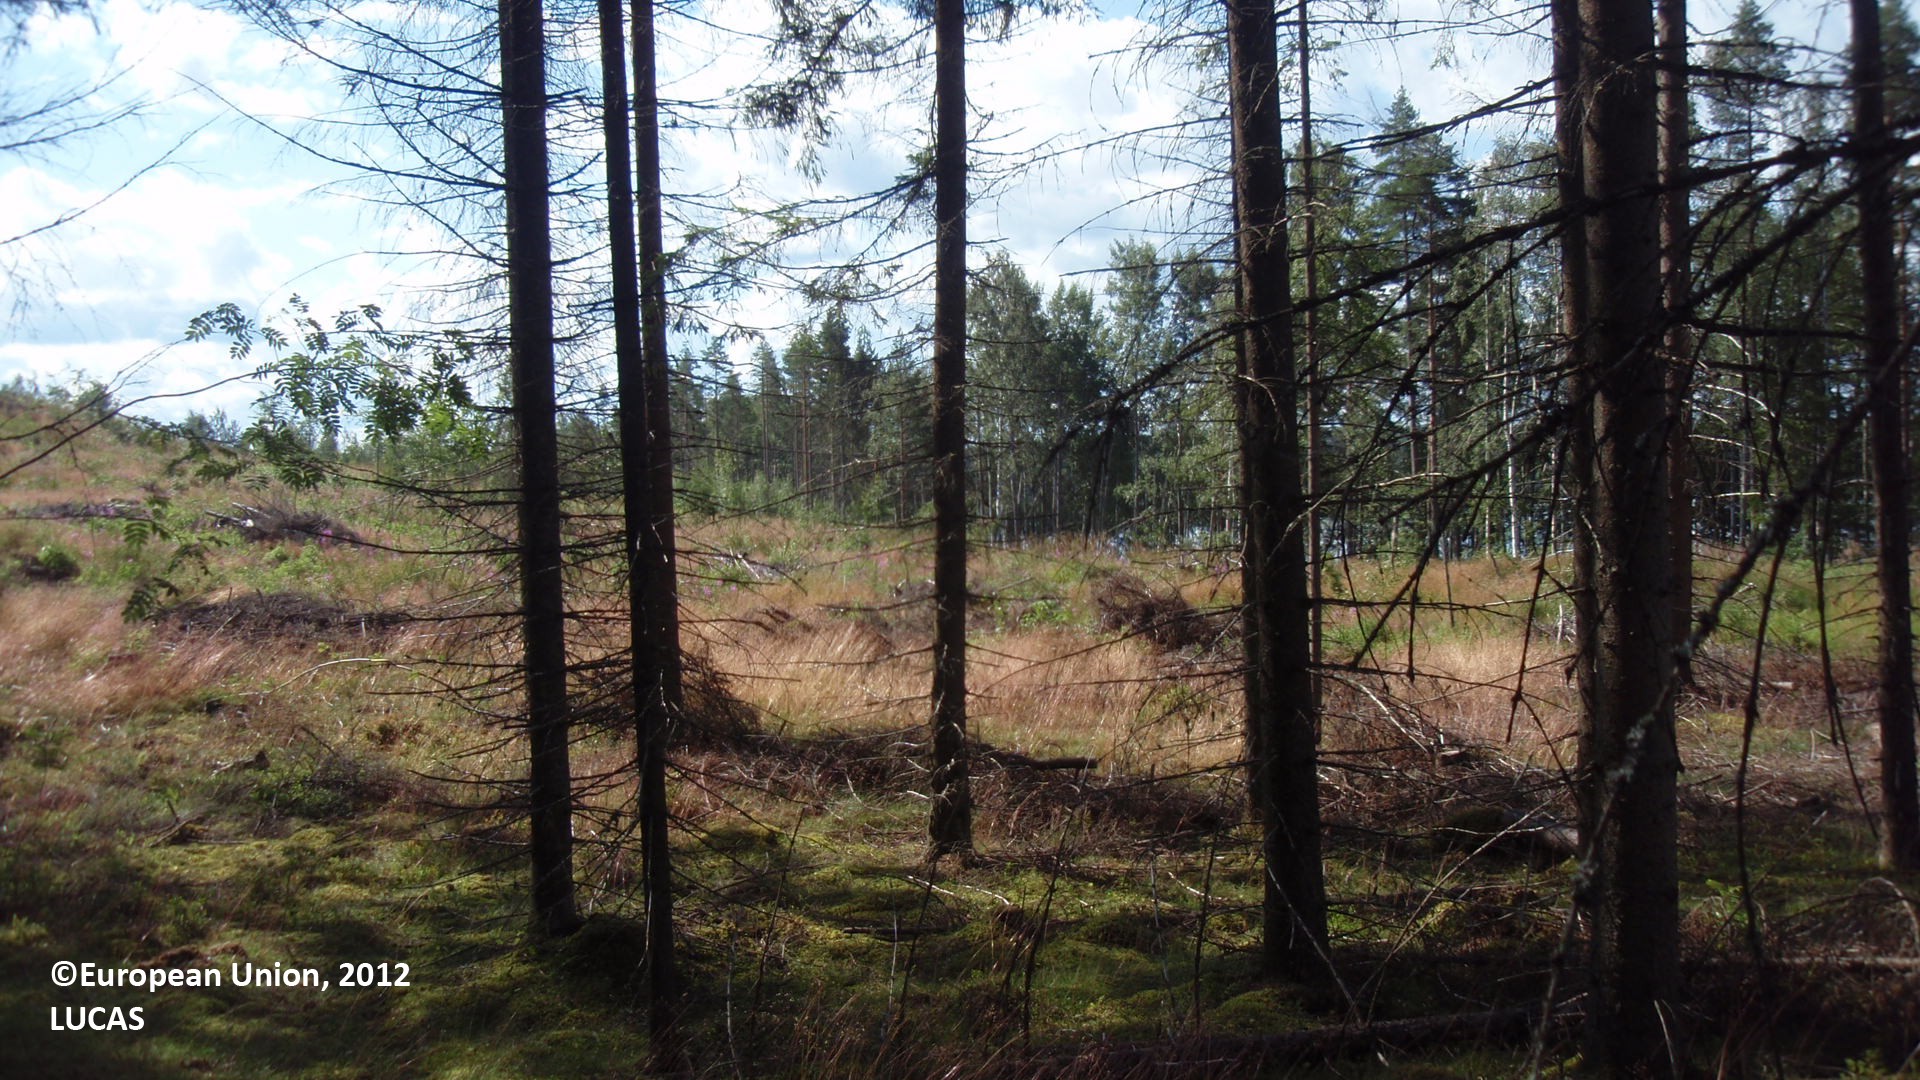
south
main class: Woodland
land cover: Spruce dominated coniferous woodland
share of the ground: 50 - 75 %
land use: Forestry
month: July
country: FI
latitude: 61.4294
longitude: 29.0722
